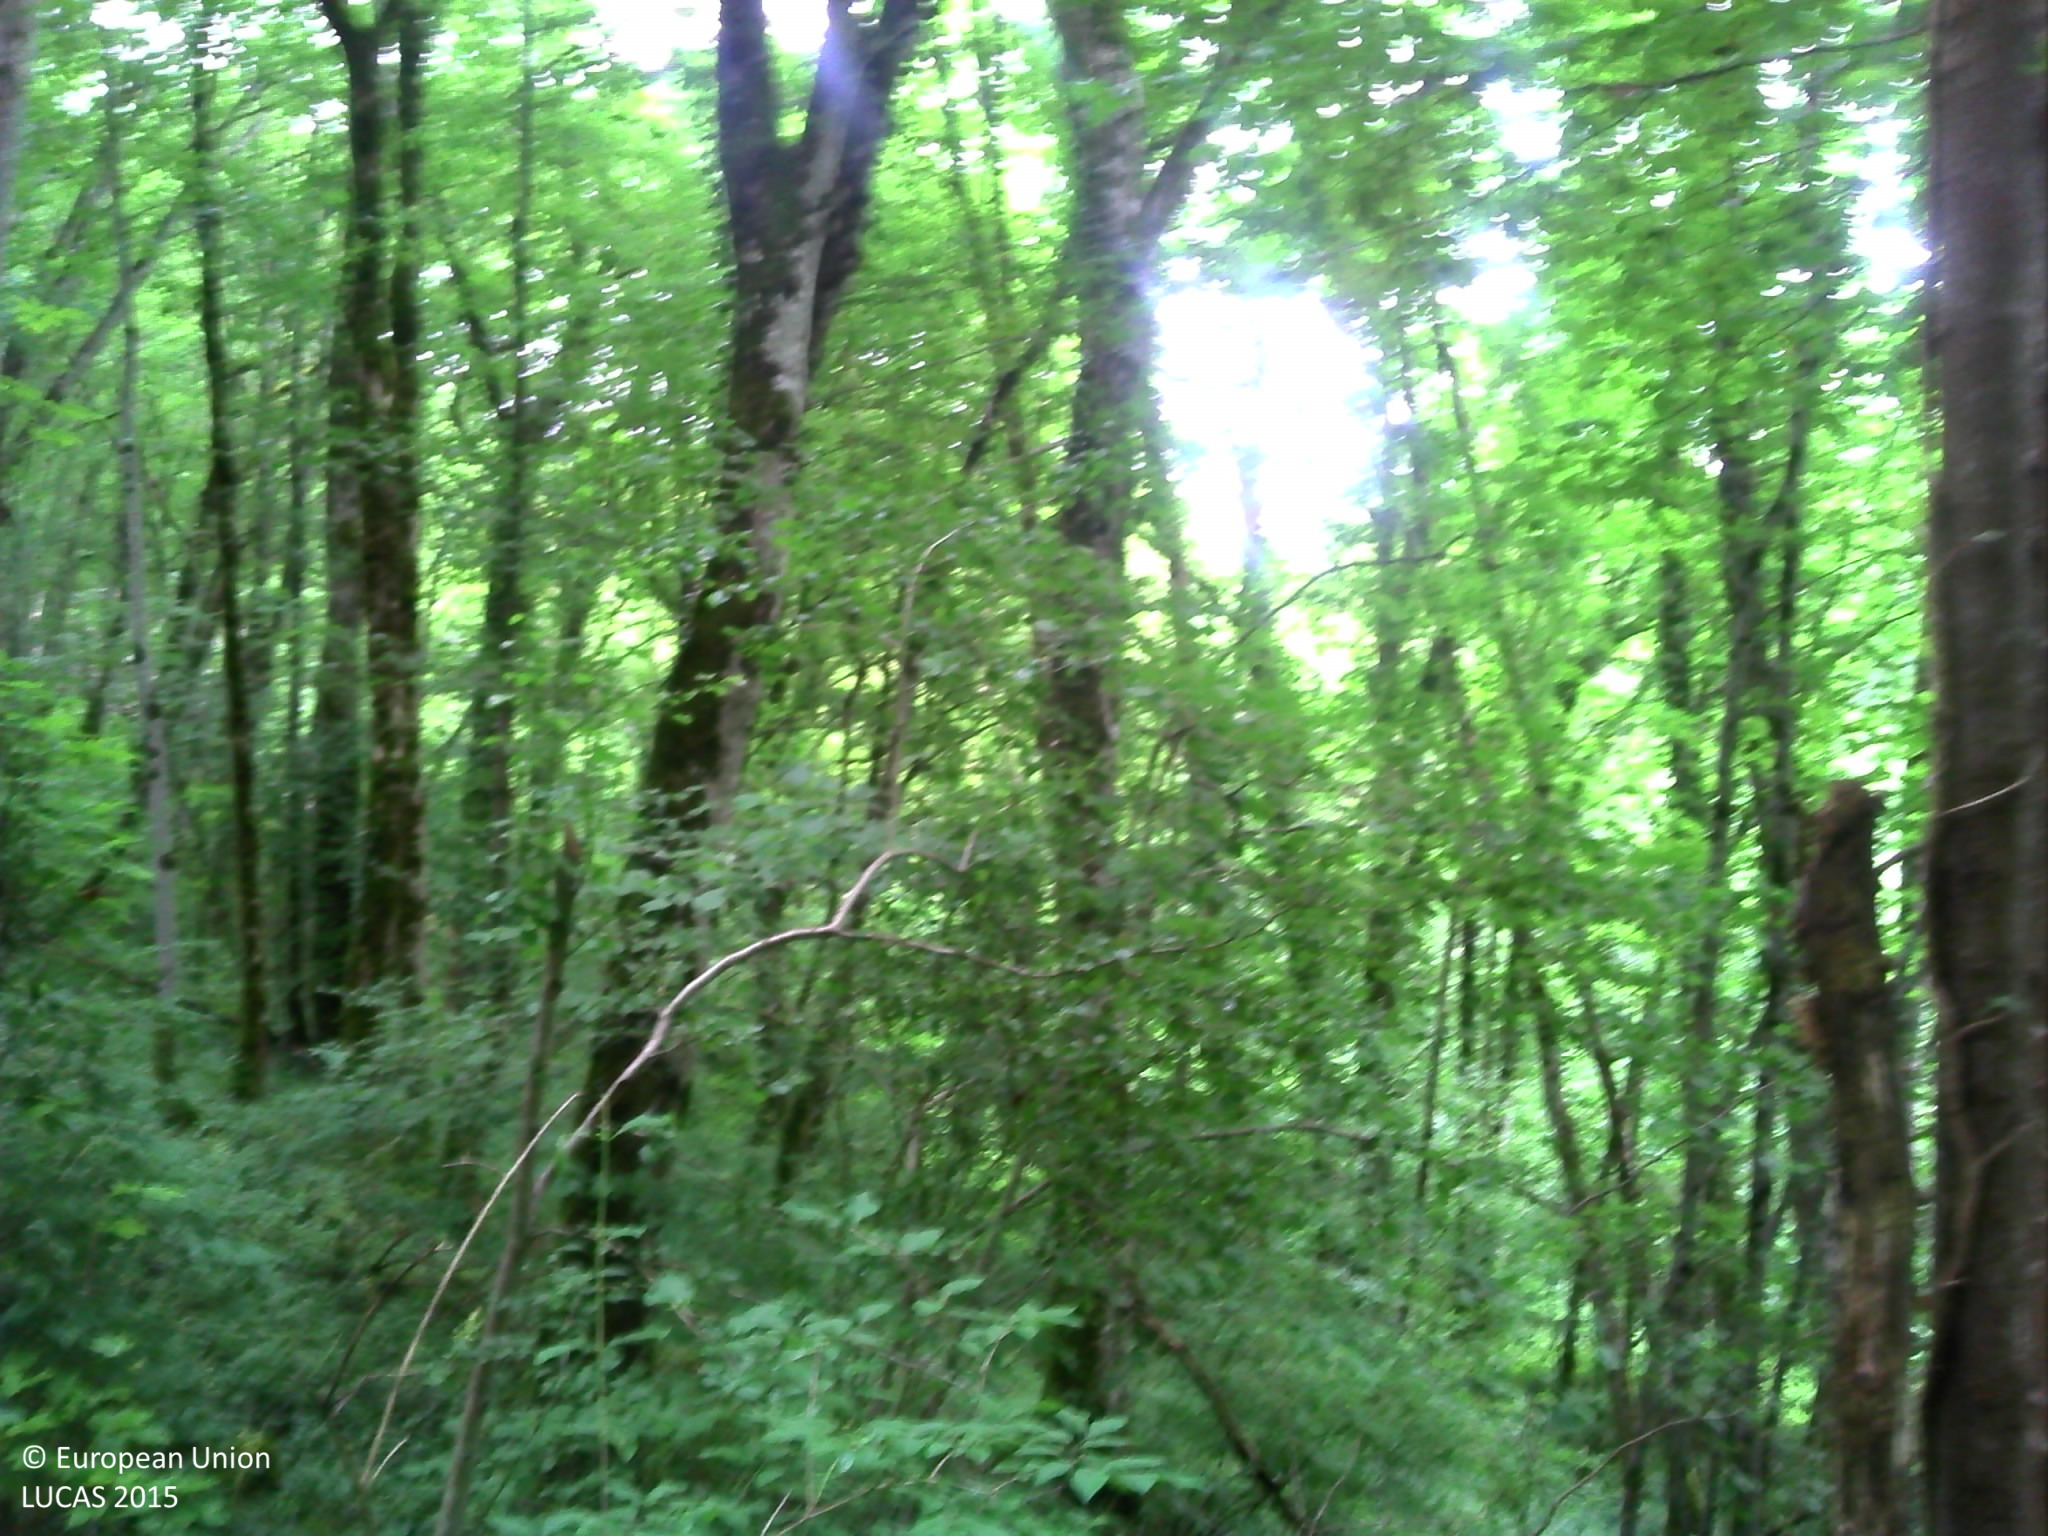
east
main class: Woodland
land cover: Broadleaved woodland
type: mesophytic deciduous forest
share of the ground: > 75 %
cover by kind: broadleaved forest trees 80 %, coniferous forest trees 10 %, herbaceous plants 5 %, lichens and mosses 5 %
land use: Forestry
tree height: > 5 m
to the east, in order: Broadleaved woodland; Tracks
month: June
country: FR
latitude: 48.1922
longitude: 5.2236
